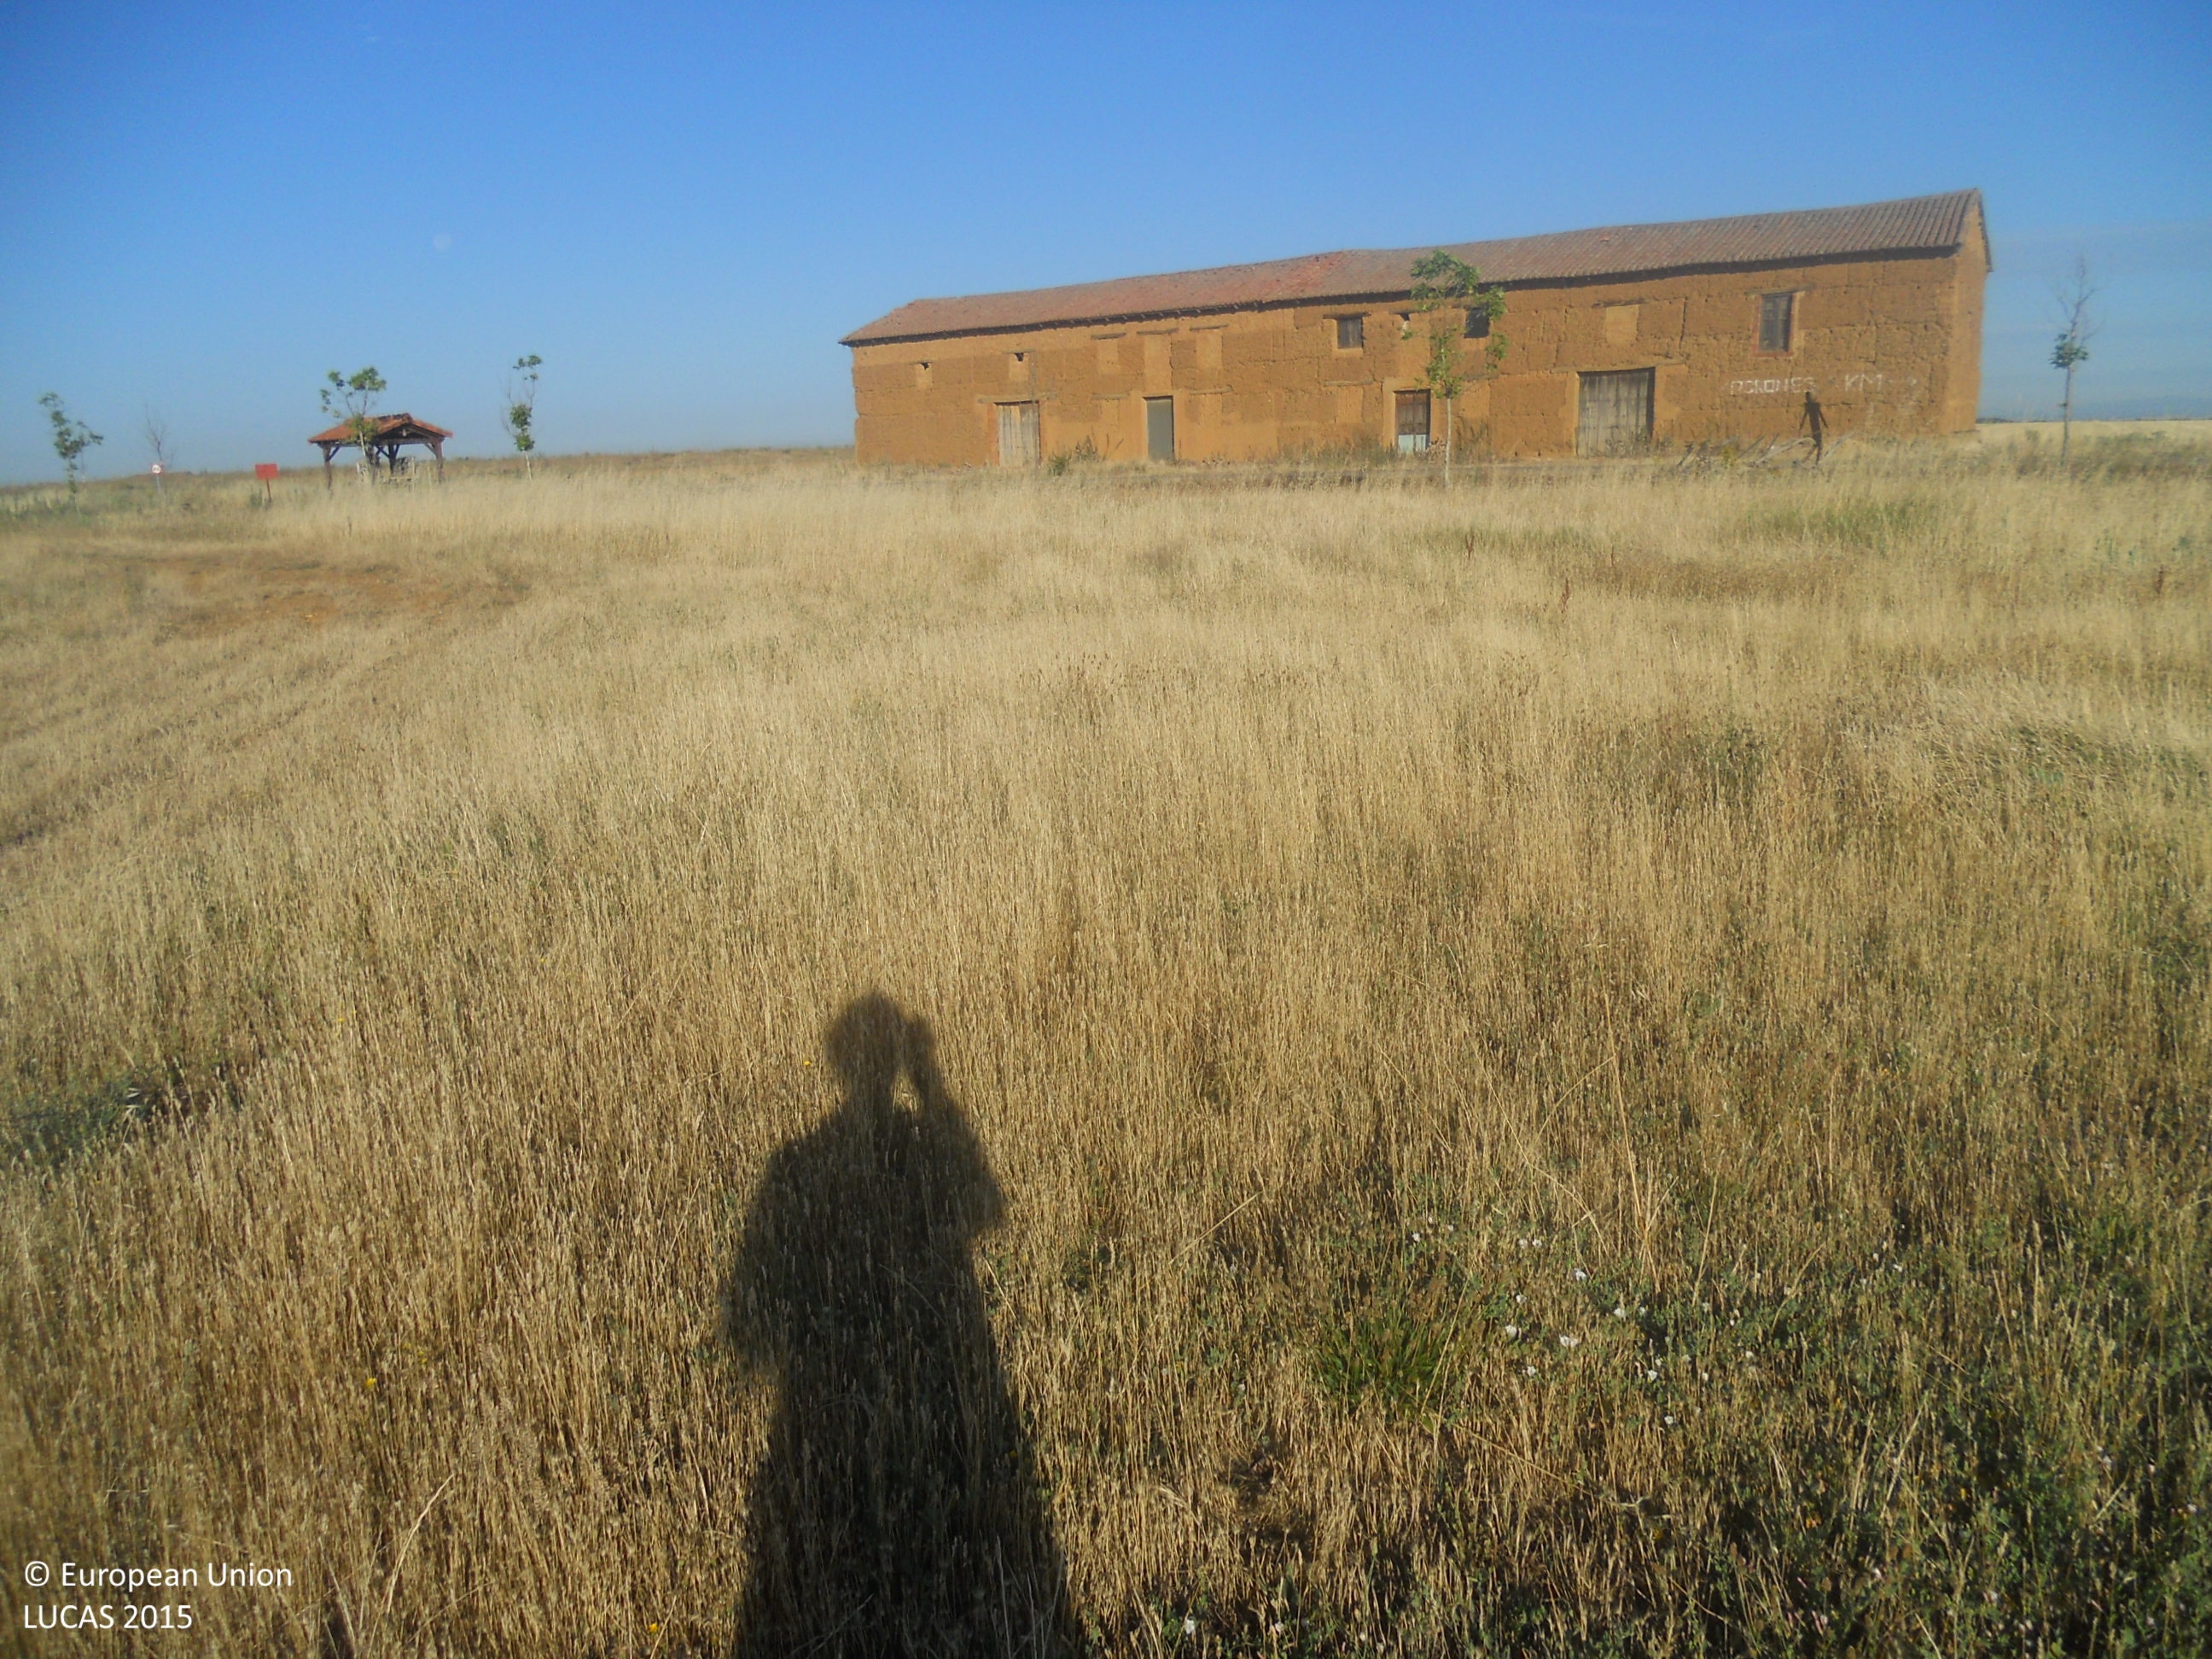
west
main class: Grassland
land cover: Grassland without tree/shrub cover
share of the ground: > 75 %
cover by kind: herbaceous plants 100 %
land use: Abandoned areas
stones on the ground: > 50 %
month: July
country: ES
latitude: 42.4557
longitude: -5.3020
